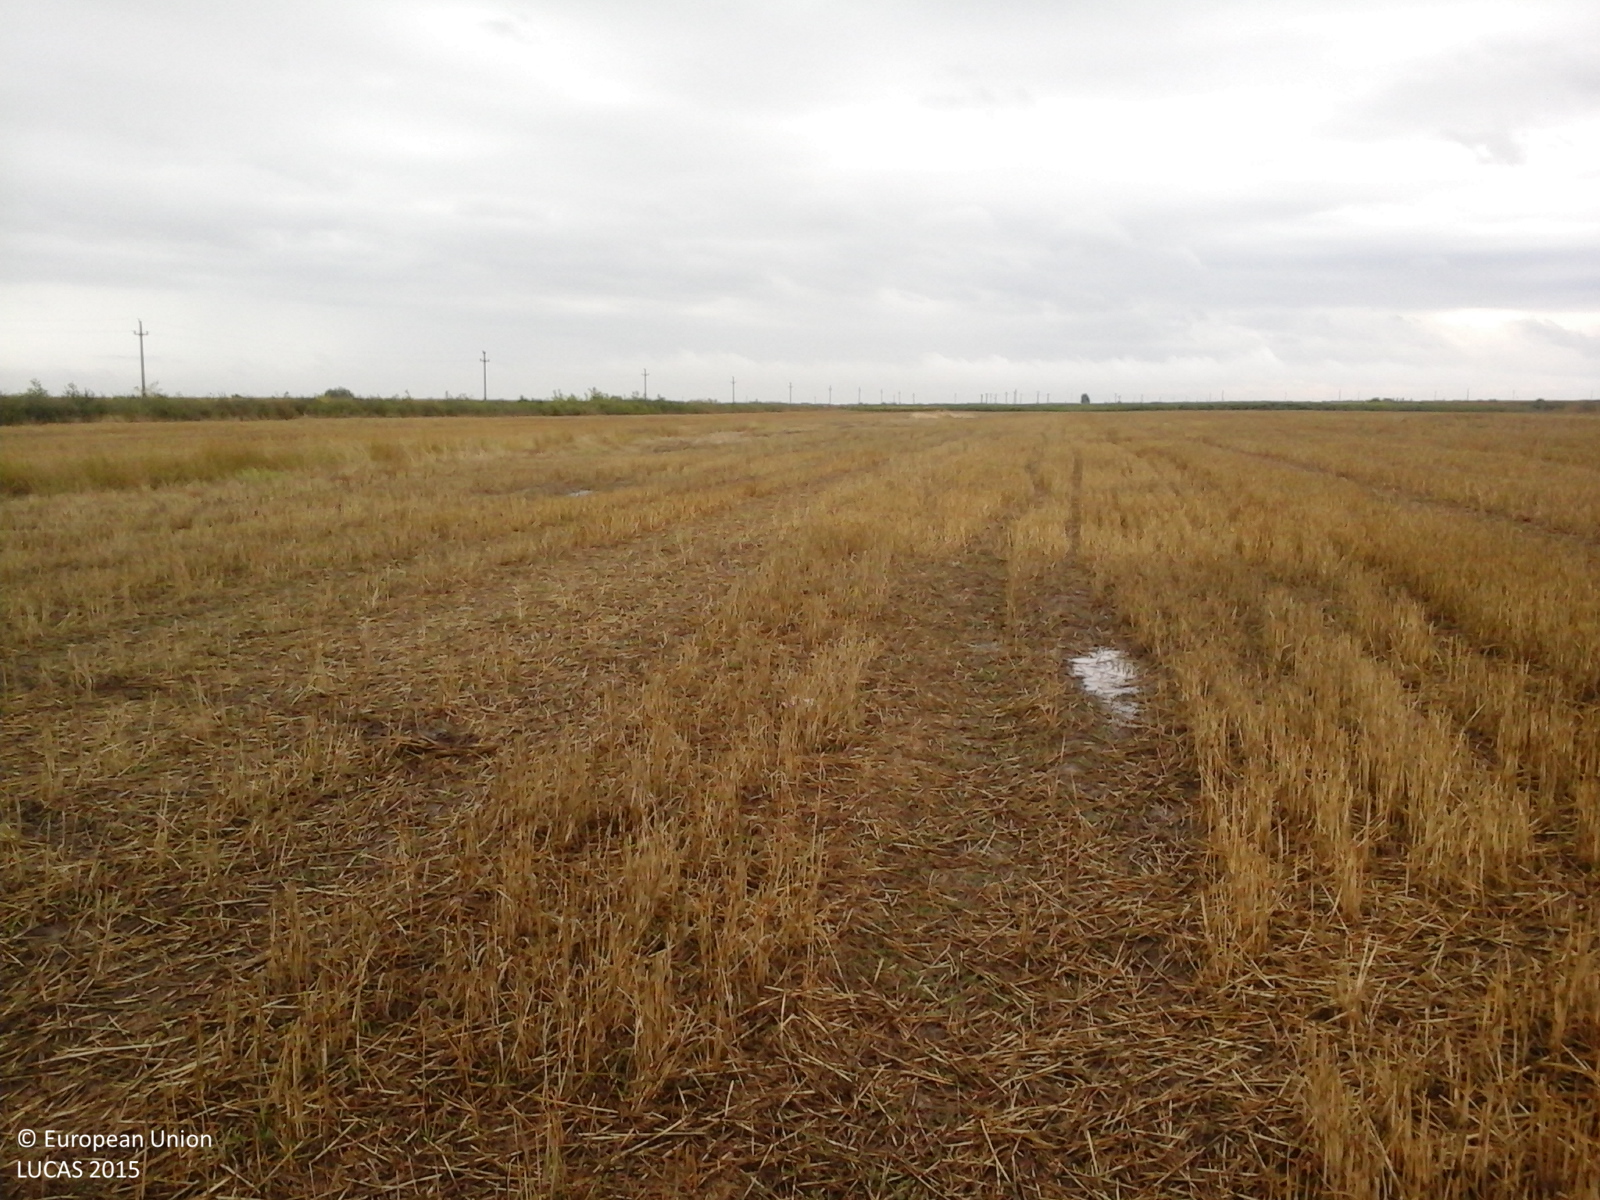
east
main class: Cropland
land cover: Common wheat
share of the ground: 50 - 75 %
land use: Agriculture (excluding fallow land and kitchen gardens)
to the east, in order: Common wheat
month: August
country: RO
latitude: 45.5659
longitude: 20.9816
